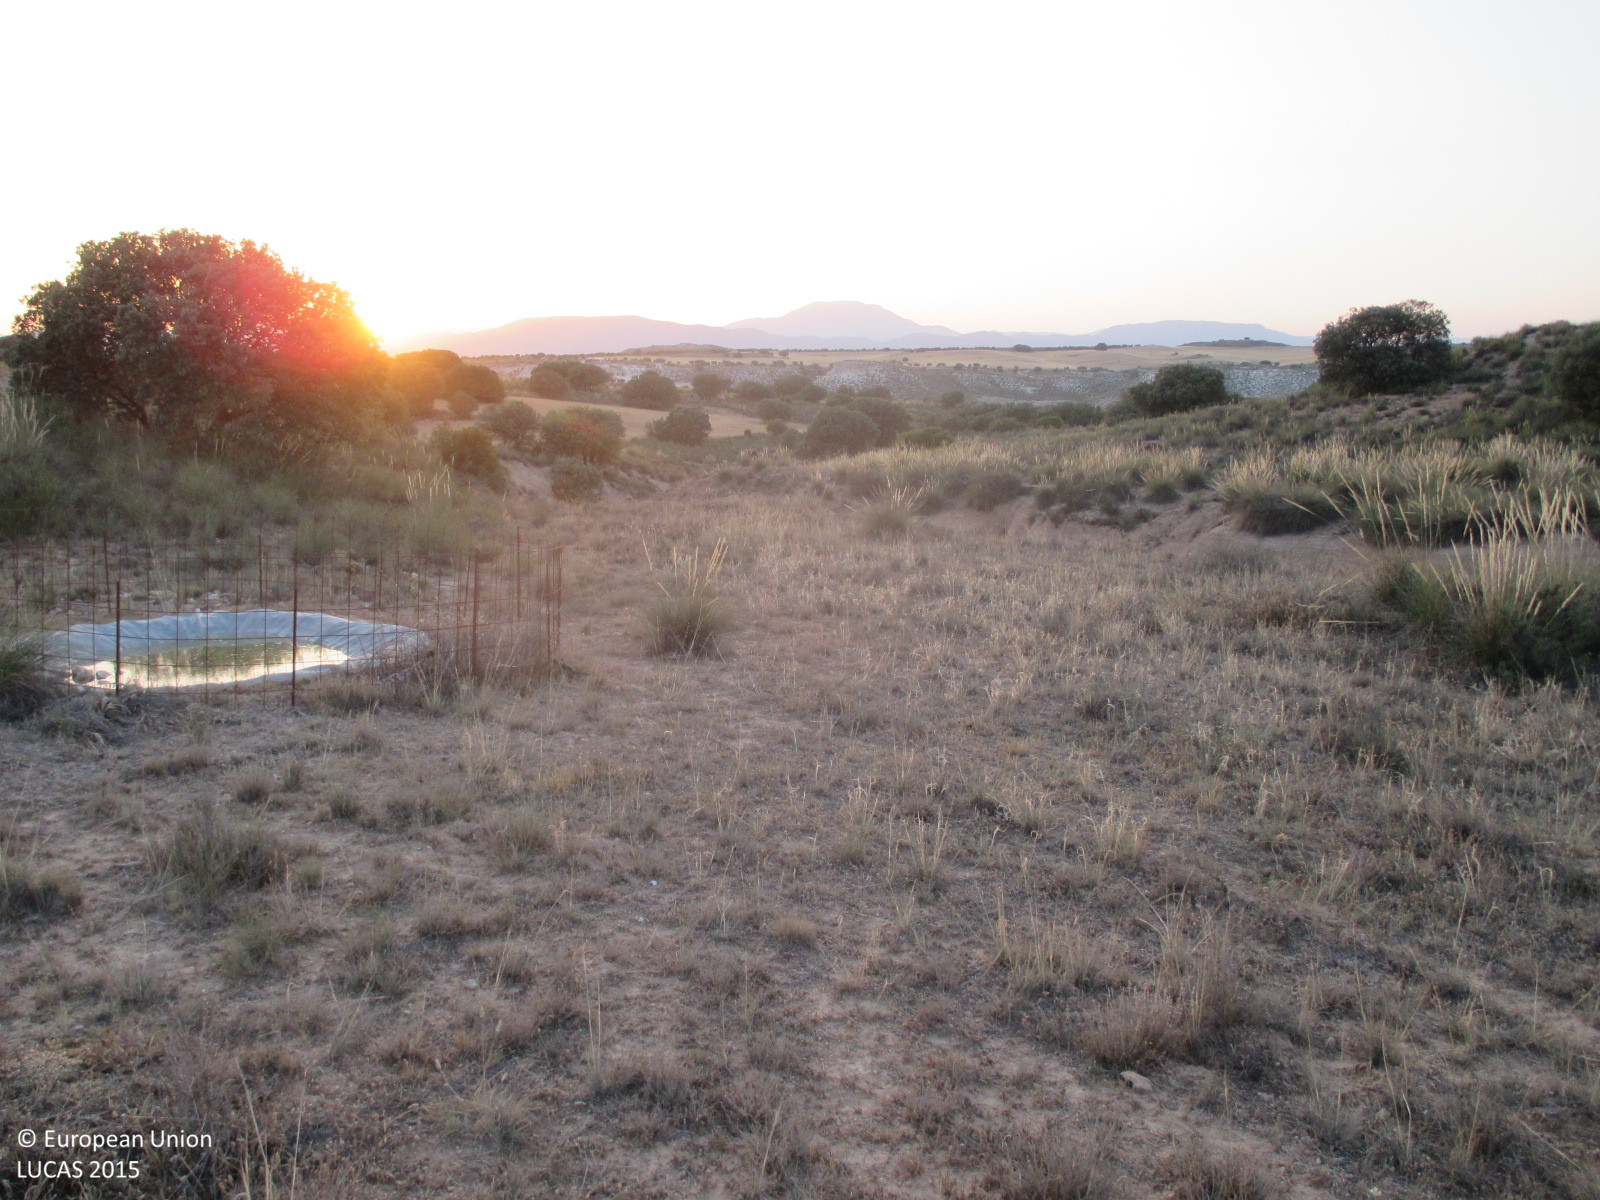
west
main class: Grassland
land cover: Grassland without tree/shrub cover
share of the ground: > 75 %
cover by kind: herbaceous plants 100 %
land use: Semi-natural and natural areas not in use
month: June
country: ES
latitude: 37.7637
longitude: -2.3498
